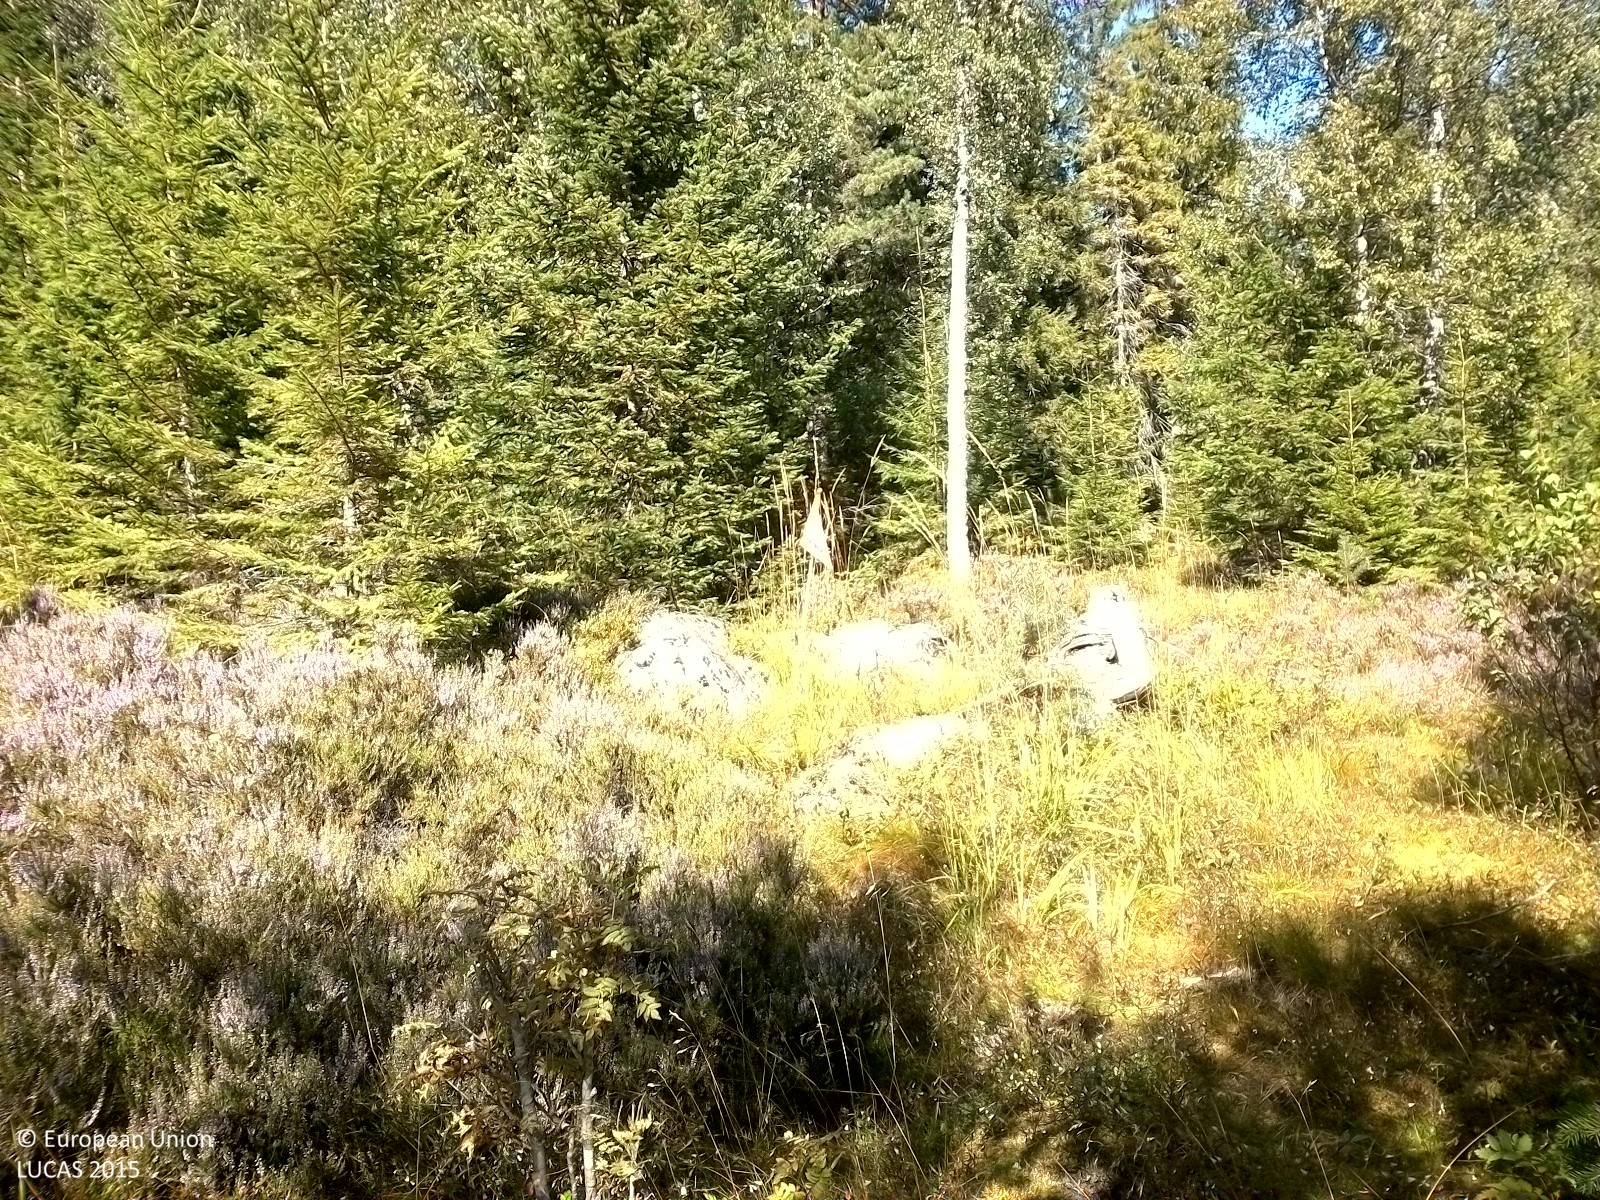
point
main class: Woodland
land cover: Spruce dominated mixed woodland
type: boreal forest
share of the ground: 25 - 50 %
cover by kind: herbaceous plants 30 %, shrubs 25 %, coniferous forest trees 20 %, broadleaved forest trees 15 %, lichens and mosses 10 %
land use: Forestry
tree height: < 5 m
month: August
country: SE
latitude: 59.4037
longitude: 15.0817
